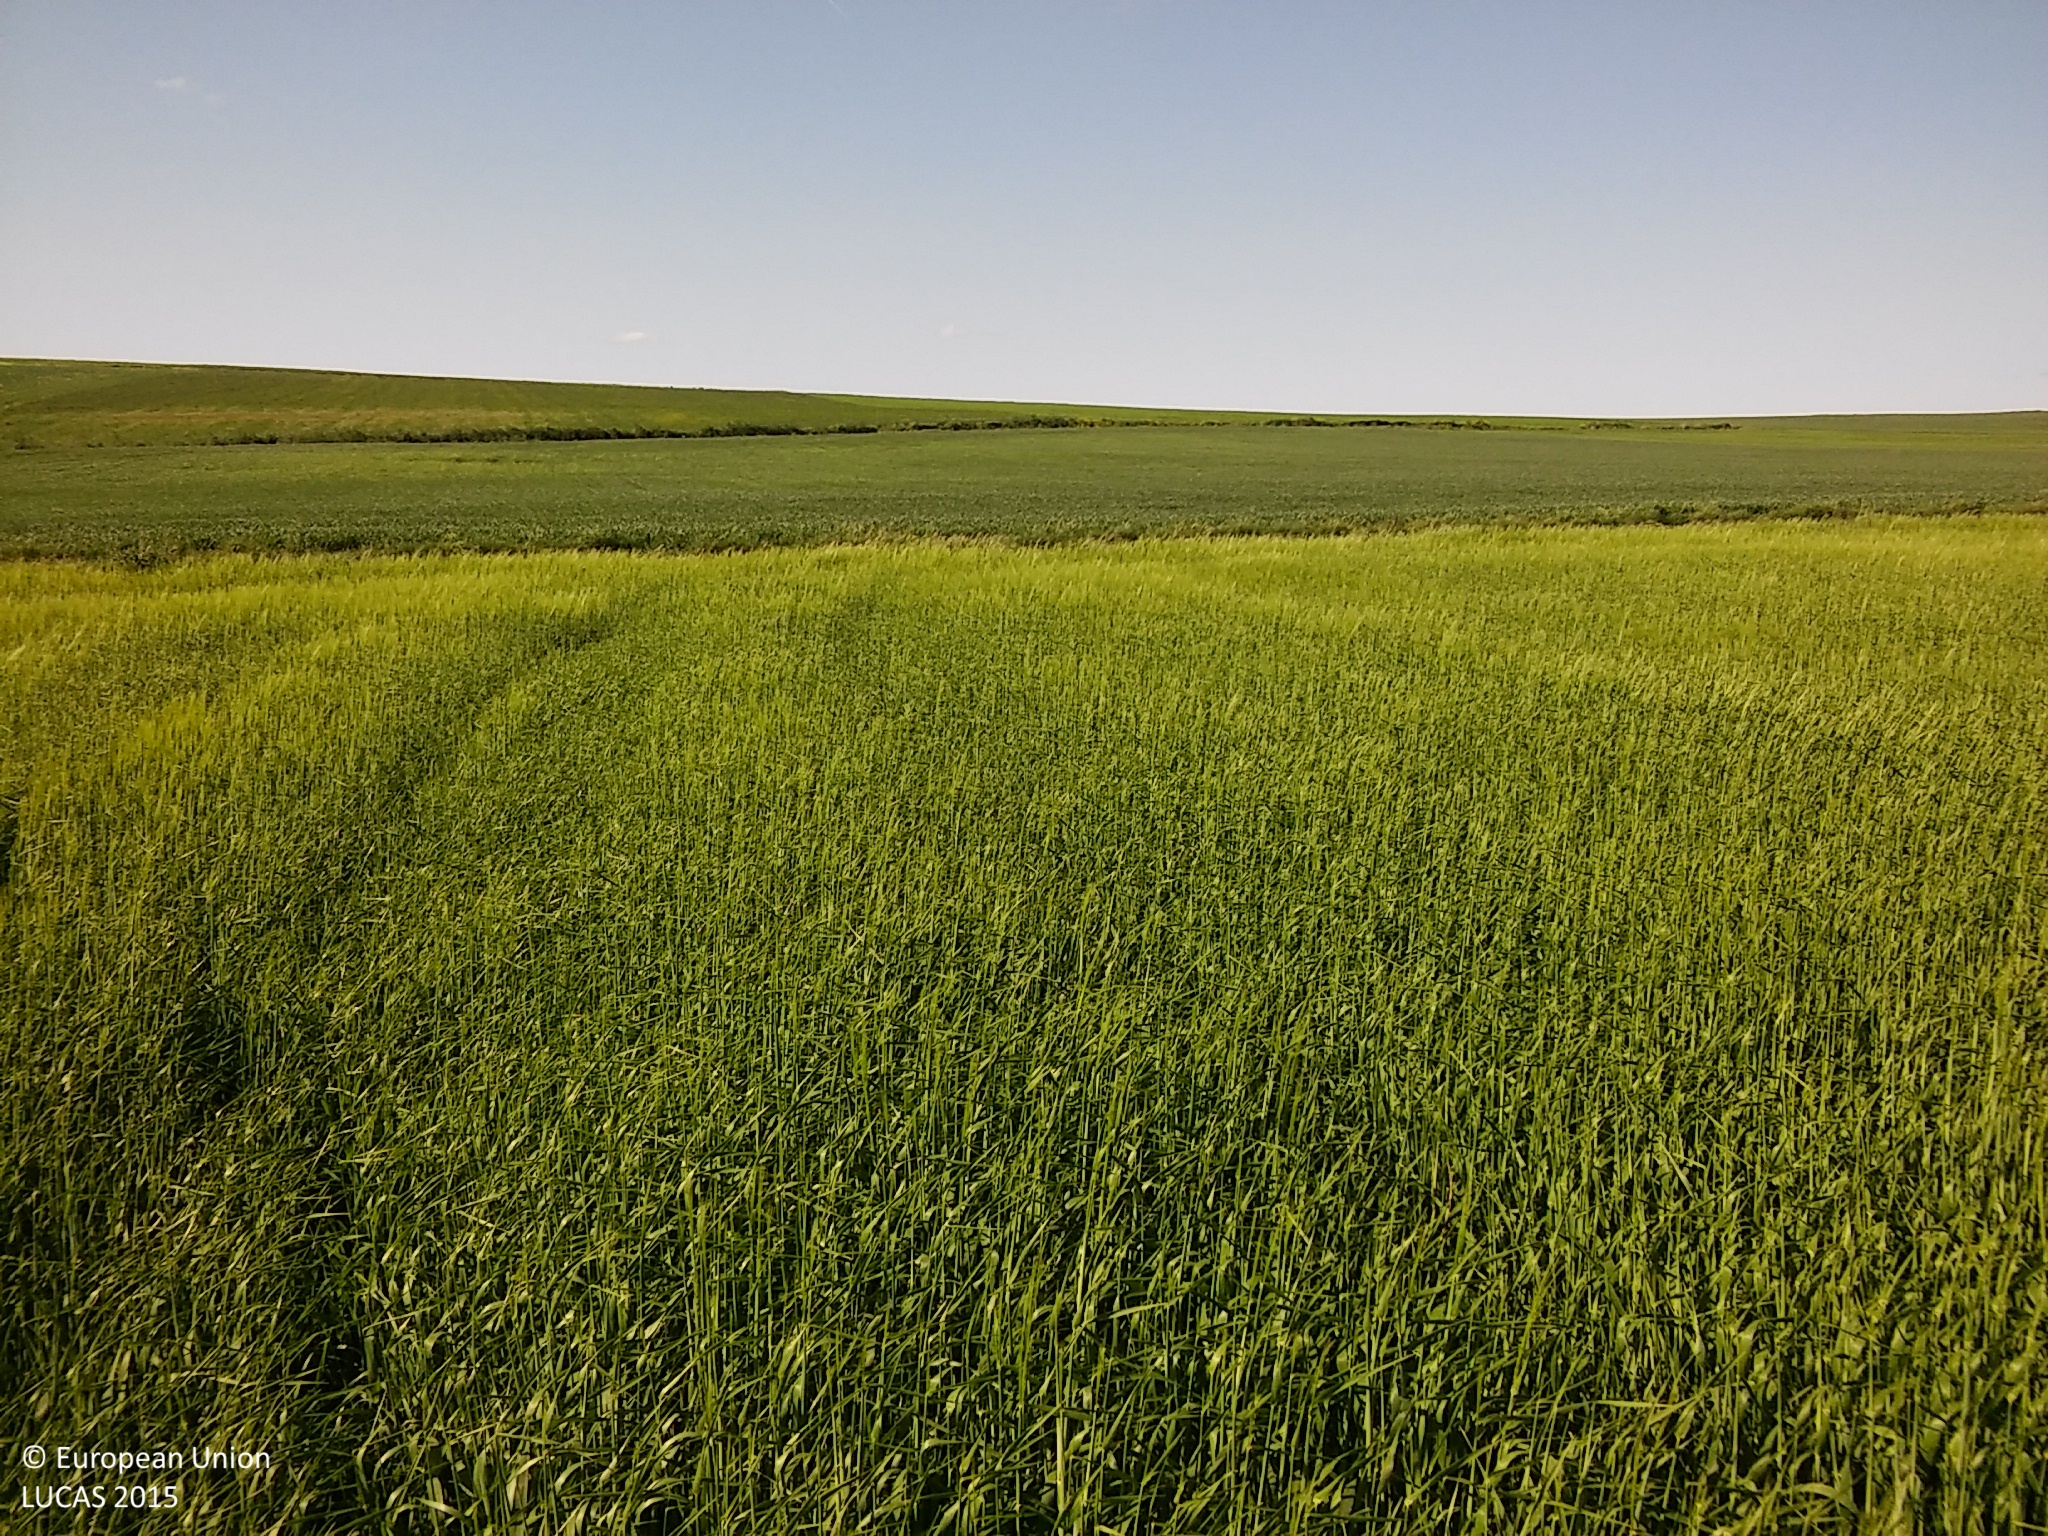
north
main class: Cropland
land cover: Barley
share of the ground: > 75 %
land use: Agriculture (excluding fallow land and kitchen gardens)
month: May
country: ES
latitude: 41.4219
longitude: -4.1152
